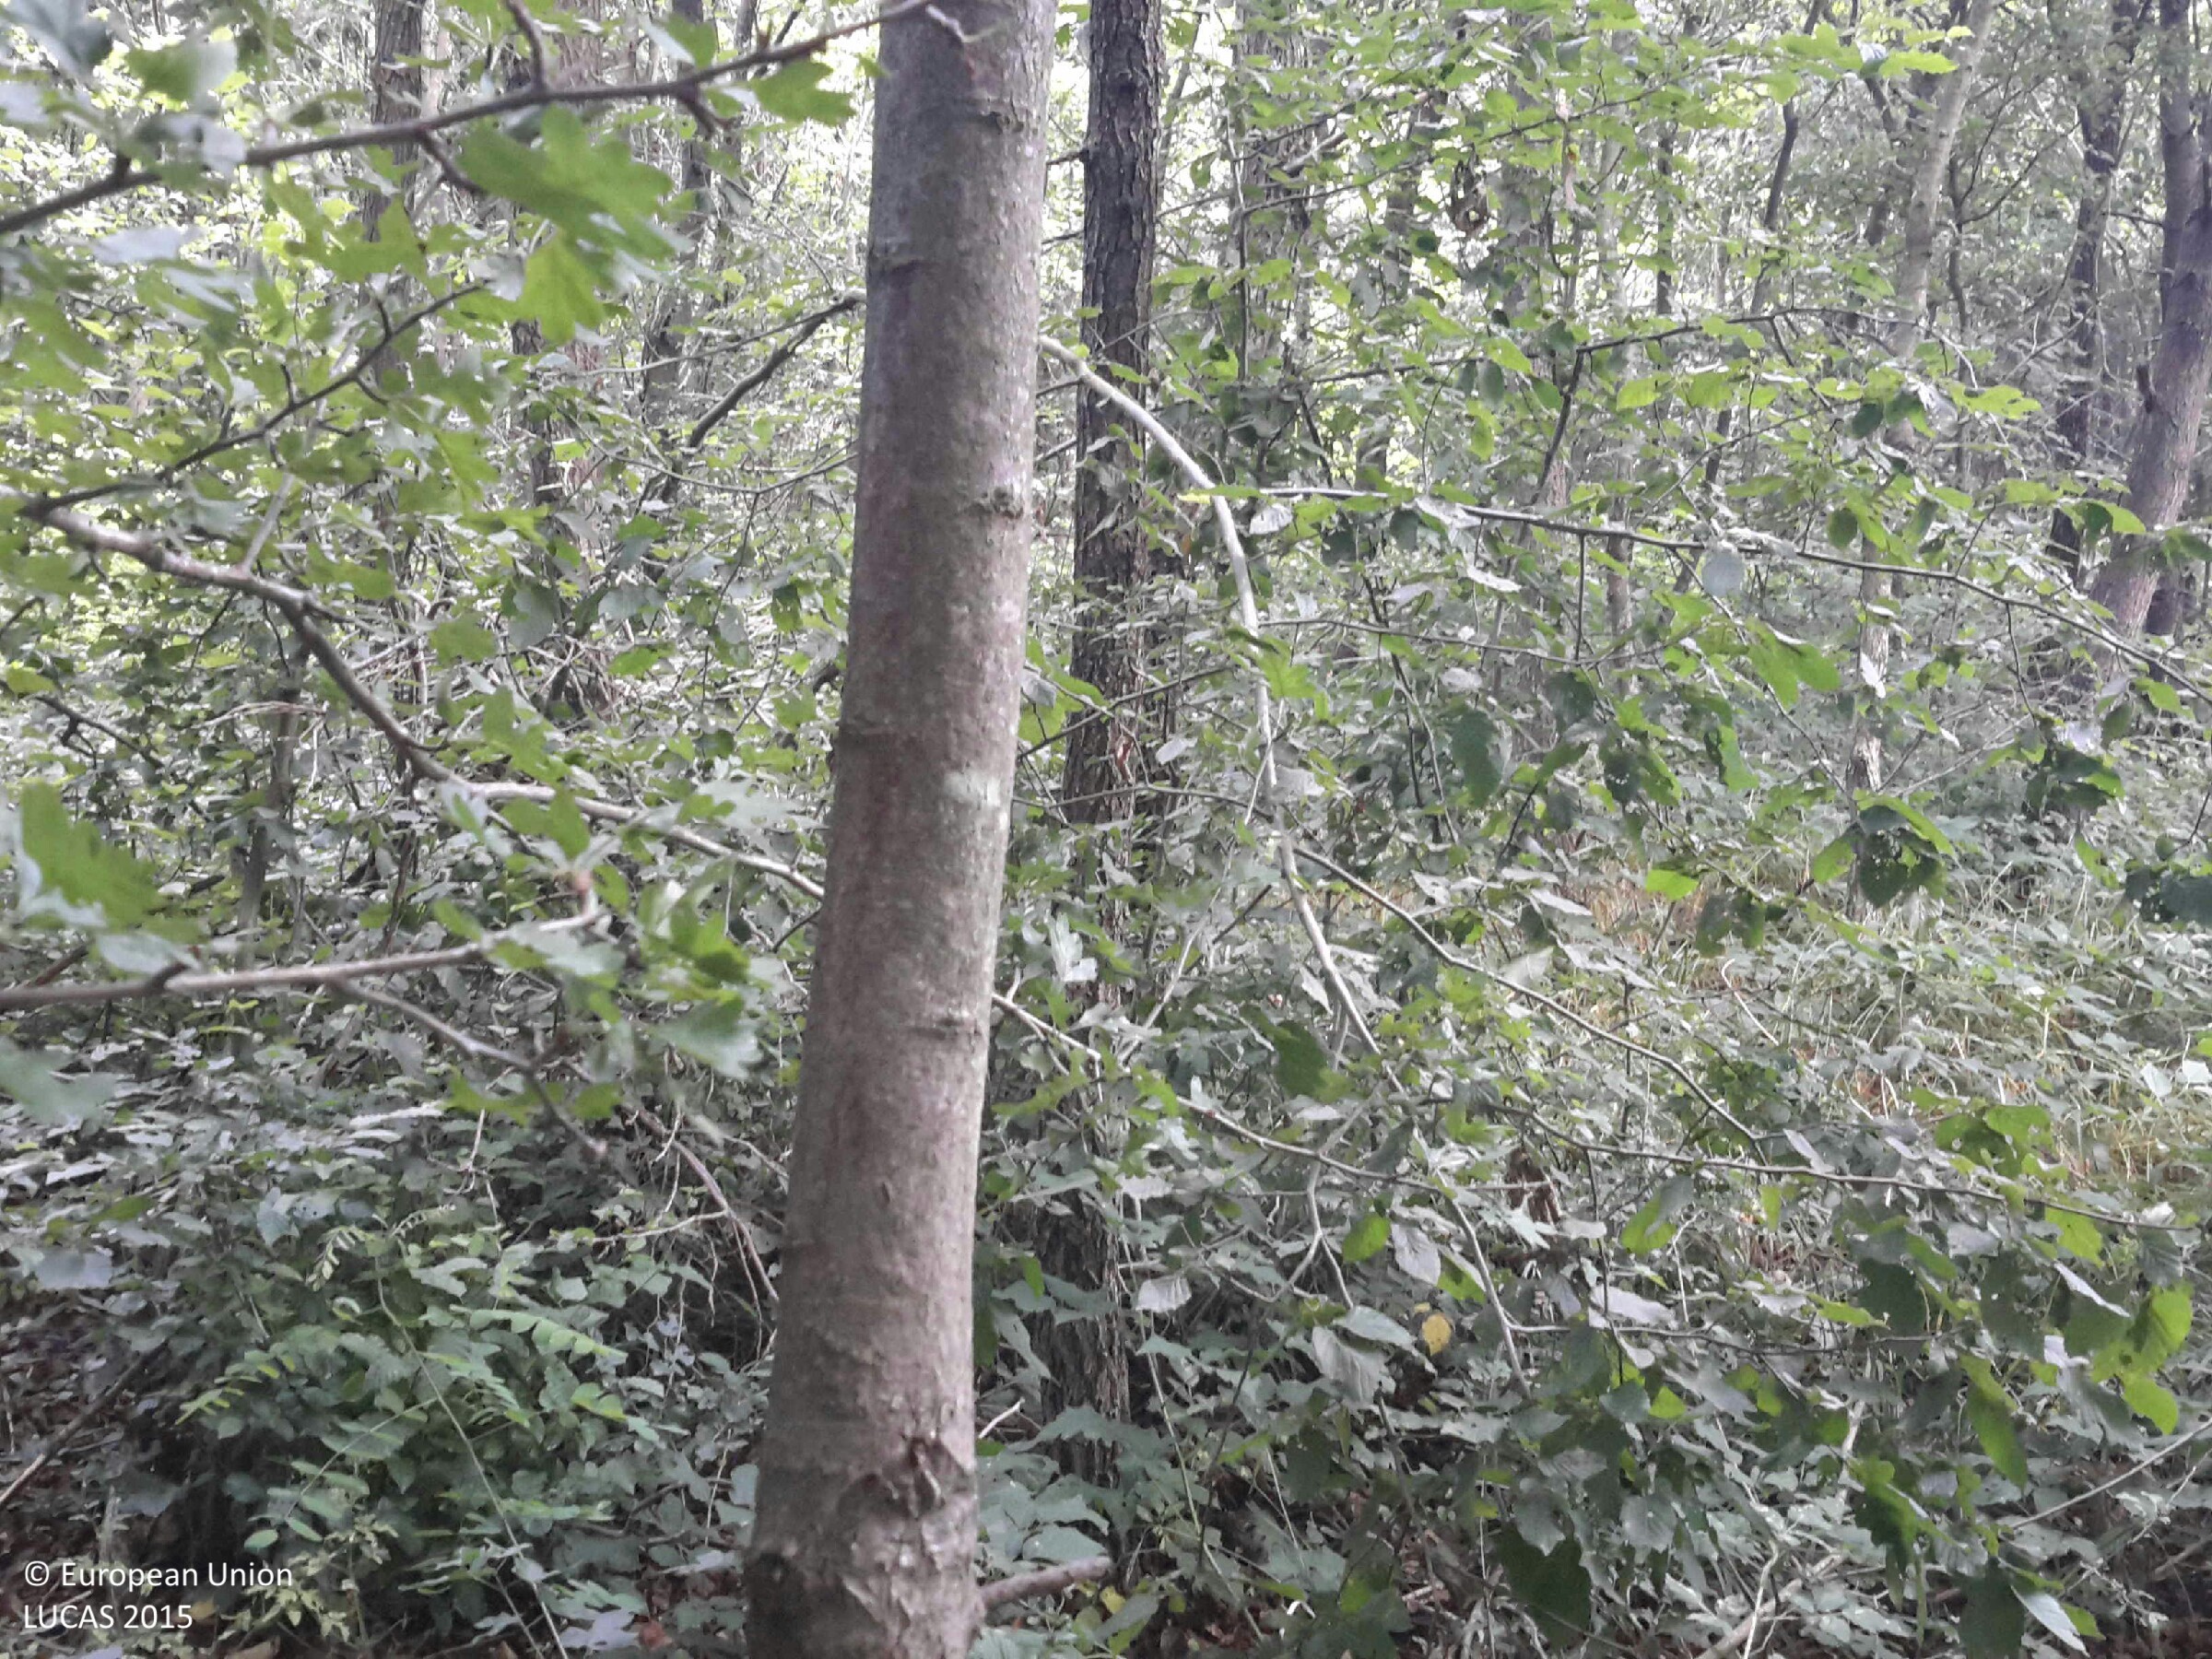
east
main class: Woodland
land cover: Broadleaved woodland
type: acidophilous oak and oak-birch forest
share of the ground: > 75 %
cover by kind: broadleaved forest trees 80 %, herbaceous plants 20 %
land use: Forestry
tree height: > 5 m
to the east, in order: Broadleaved woodland; Tracks; Broadleaved woodland; Grass margins; Tracks; Grass margins; Broadleaved woodland; Grass margins; Tracks; Grass margins; Grassland without tree/shrub cover; Broadleaved woodland
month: July
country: HU
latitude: 47.0601
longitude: 17.0220
